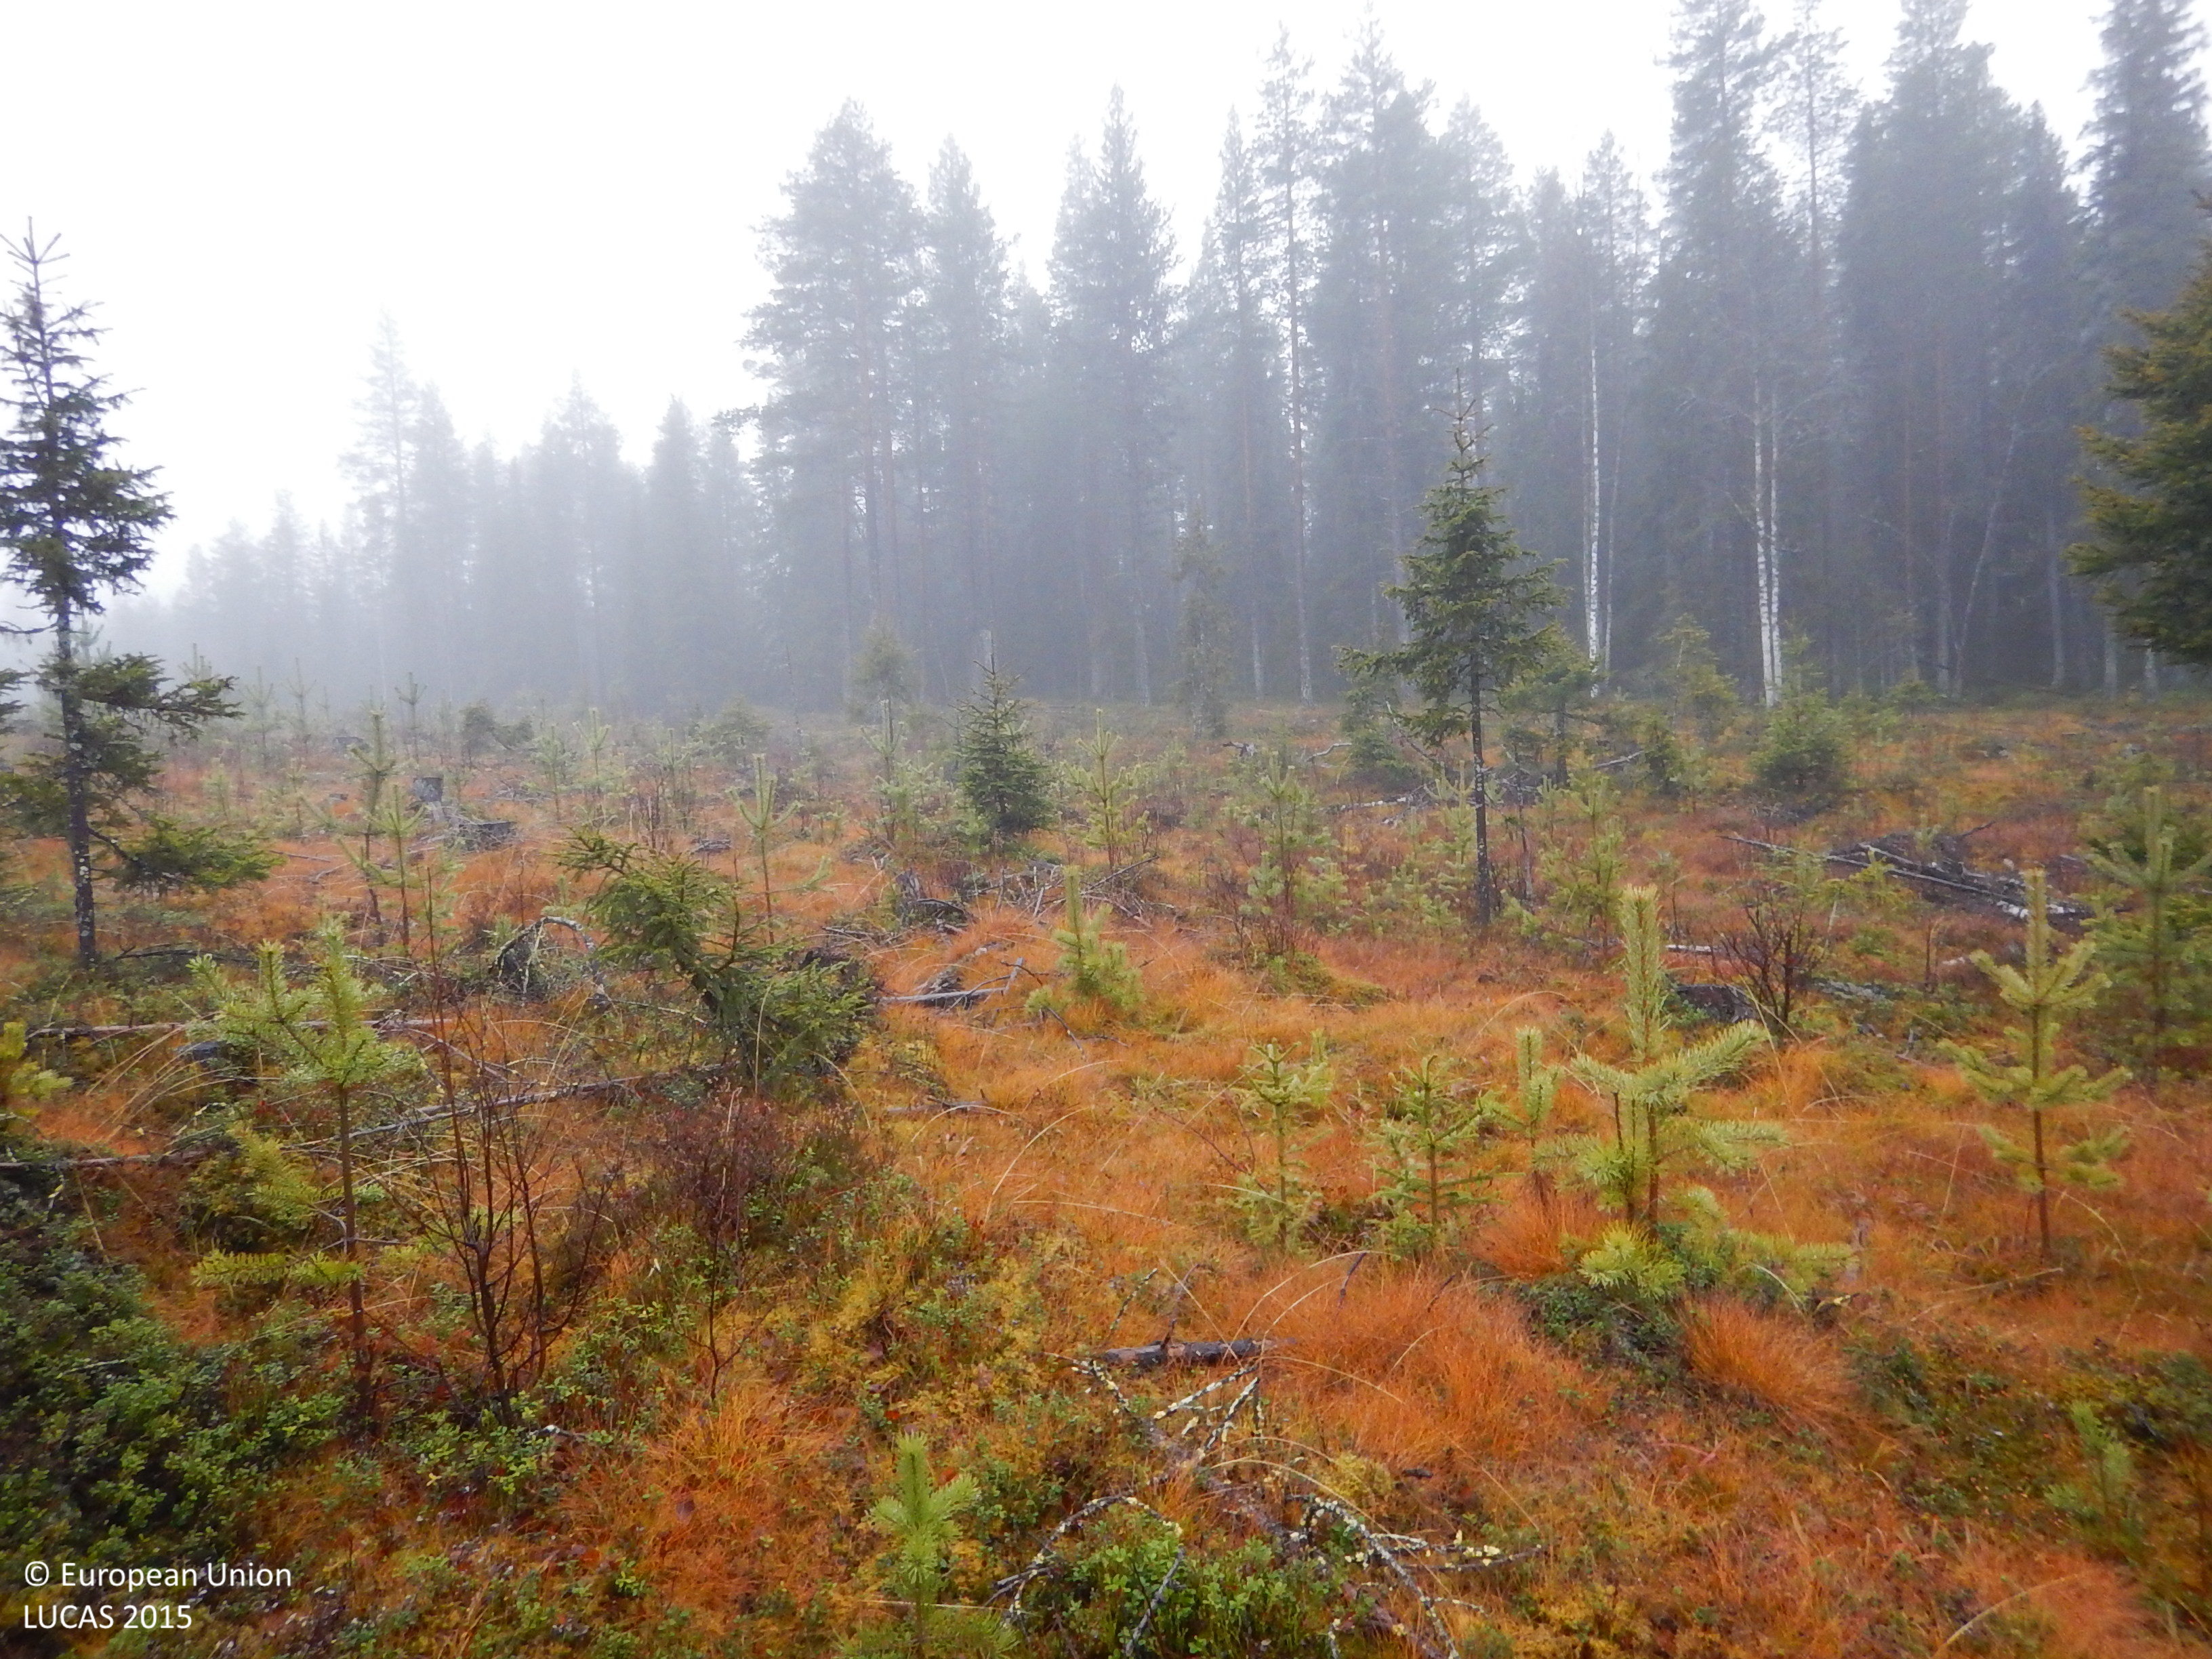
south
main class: Woodland
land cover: Pine dominated coniferous woodland
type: boreal forest
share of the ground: 25 - 50 %
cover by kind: shrubs 35 %, coniferous forest trees 20 %, lichens and mosses 20 %, herbaceous plants 15 %, broadleaved forest trees 5 %, consolidated bare surface 5 %
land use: Forestry
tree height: < 5 m
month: November
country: SE
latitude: 65.0717
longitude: 20.4970
